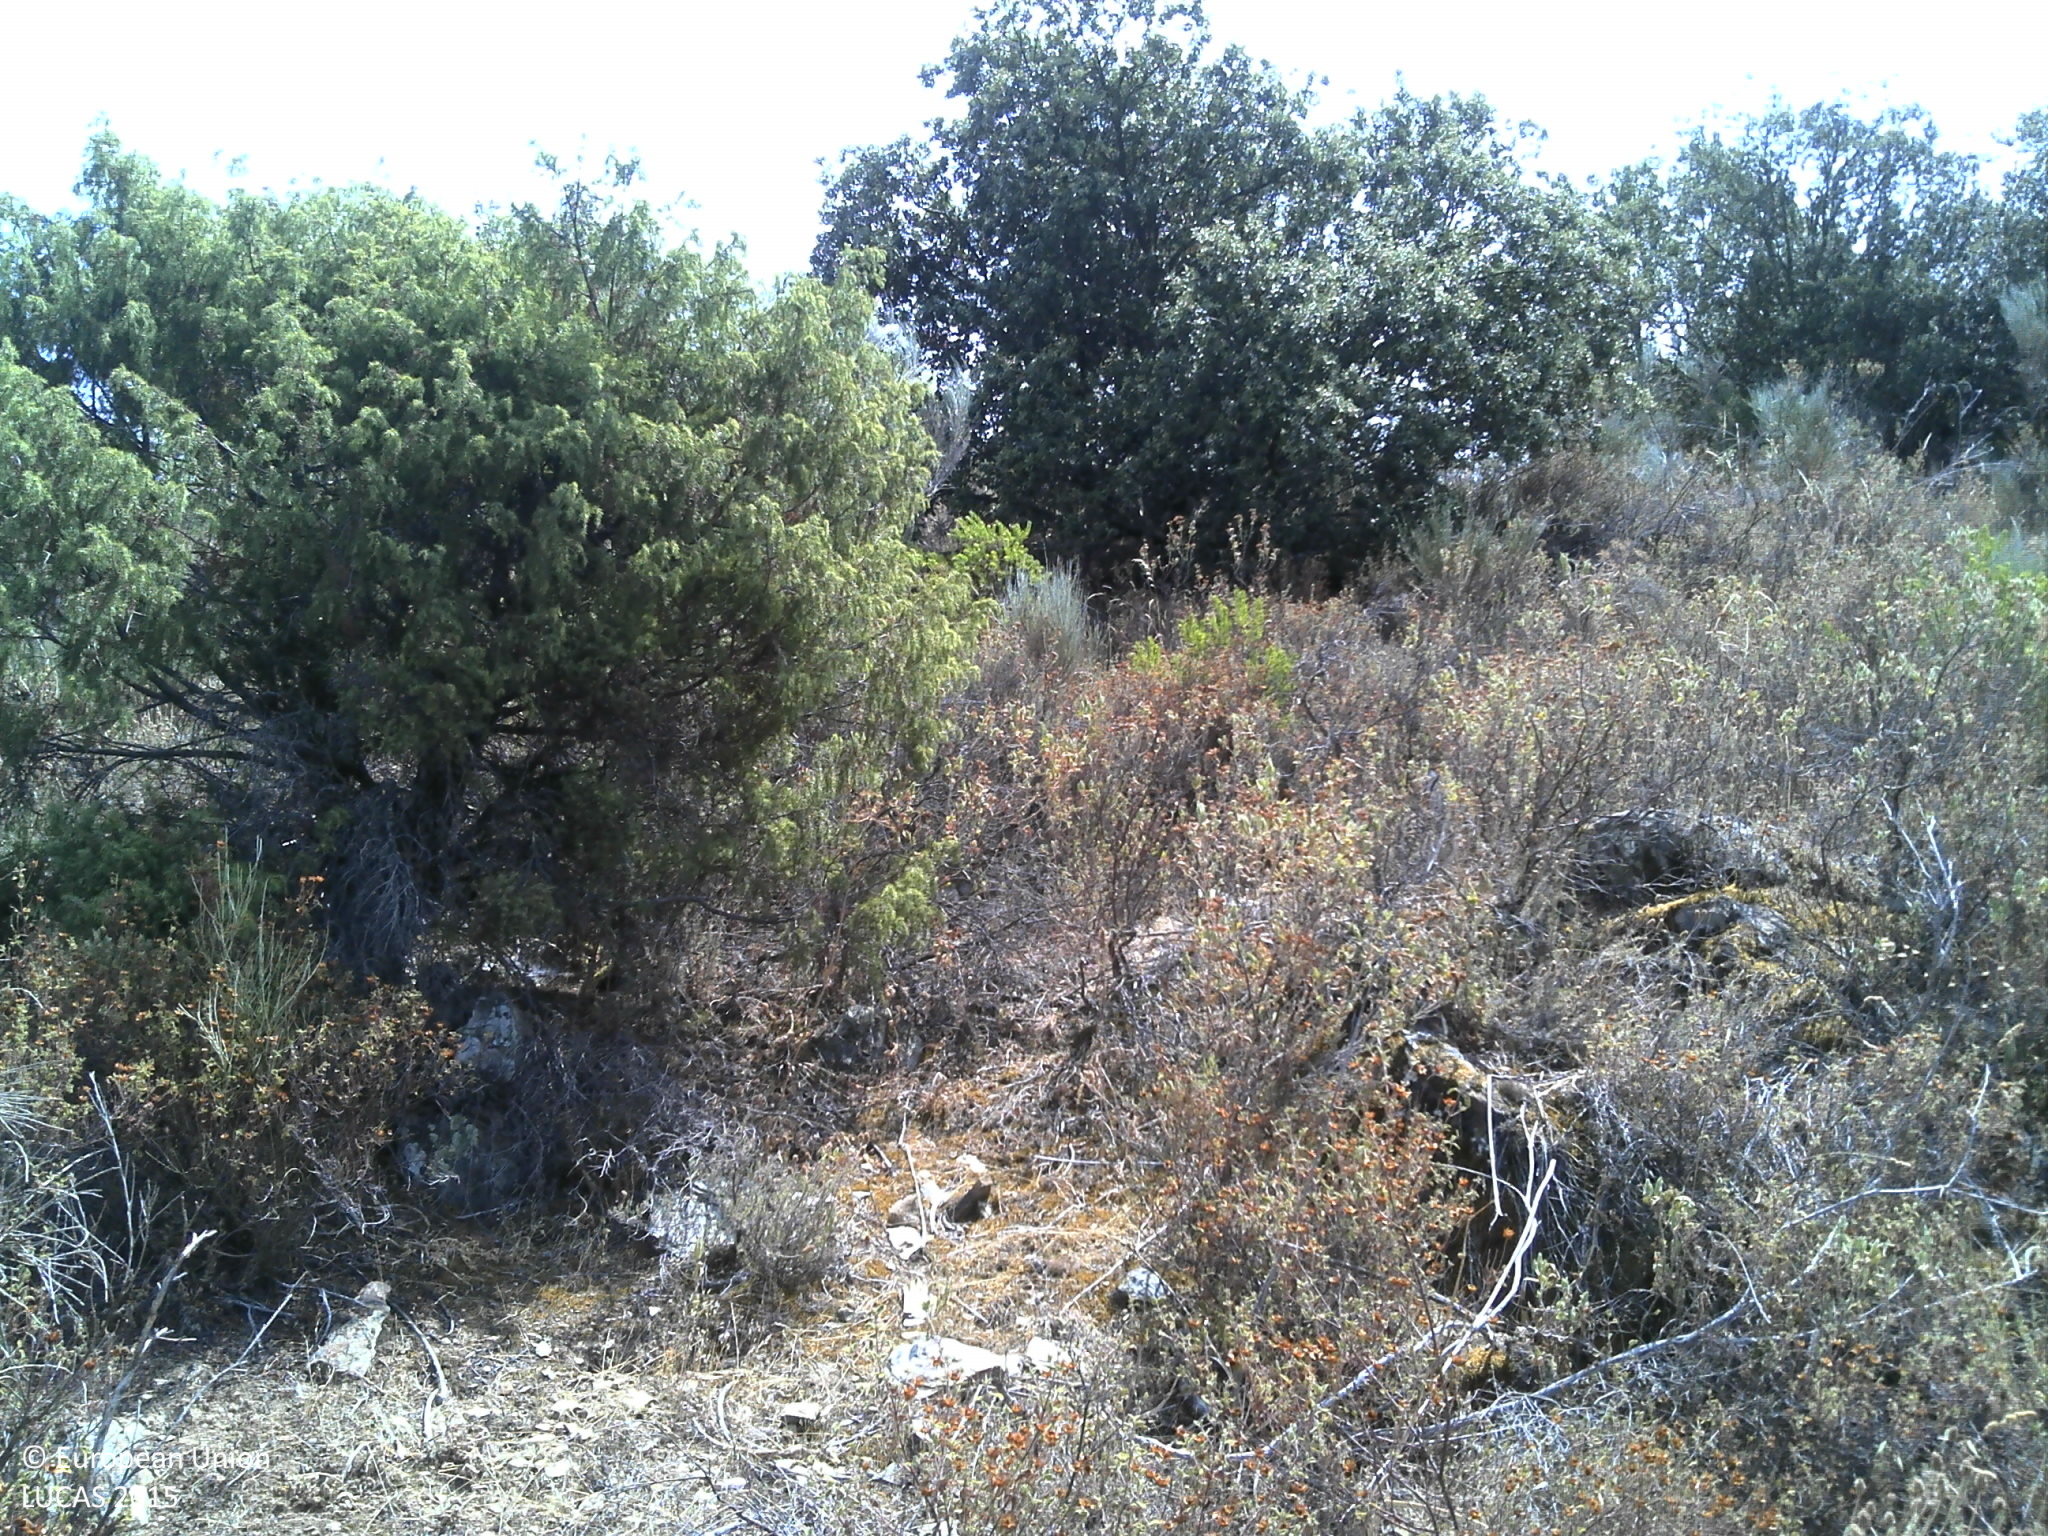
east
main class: Woodland
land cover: Broadleaved woodland
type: broadleaved evergreen forest
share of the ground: 10 - 25 %
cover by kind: shrubs 70 %, broadleaved forest trees 20 %, coniferous forest trees 5 %, unconsolidated bare surface 5 %
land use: Semi-natural and natural areas not in use
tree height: < 5 m
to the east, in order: Broadleaved woodland; Dry stone walls; Broadleaved woodland; Dry stone walls; Broadleaved woodland; Dry stone walls; Nuts trees; Dry stone walls; Nuts trees; Dry stone walls; Vineyards; Dry stone walls; Nuts trees; Broadleaved woodland; Other coniferous woodland; Tracks; Nuts trees; Dry stone walls; Nuts trees; Tracks; Dry stone walls; Nuts trees
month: July
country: PT
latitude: 41.1284
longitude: -7.3293
